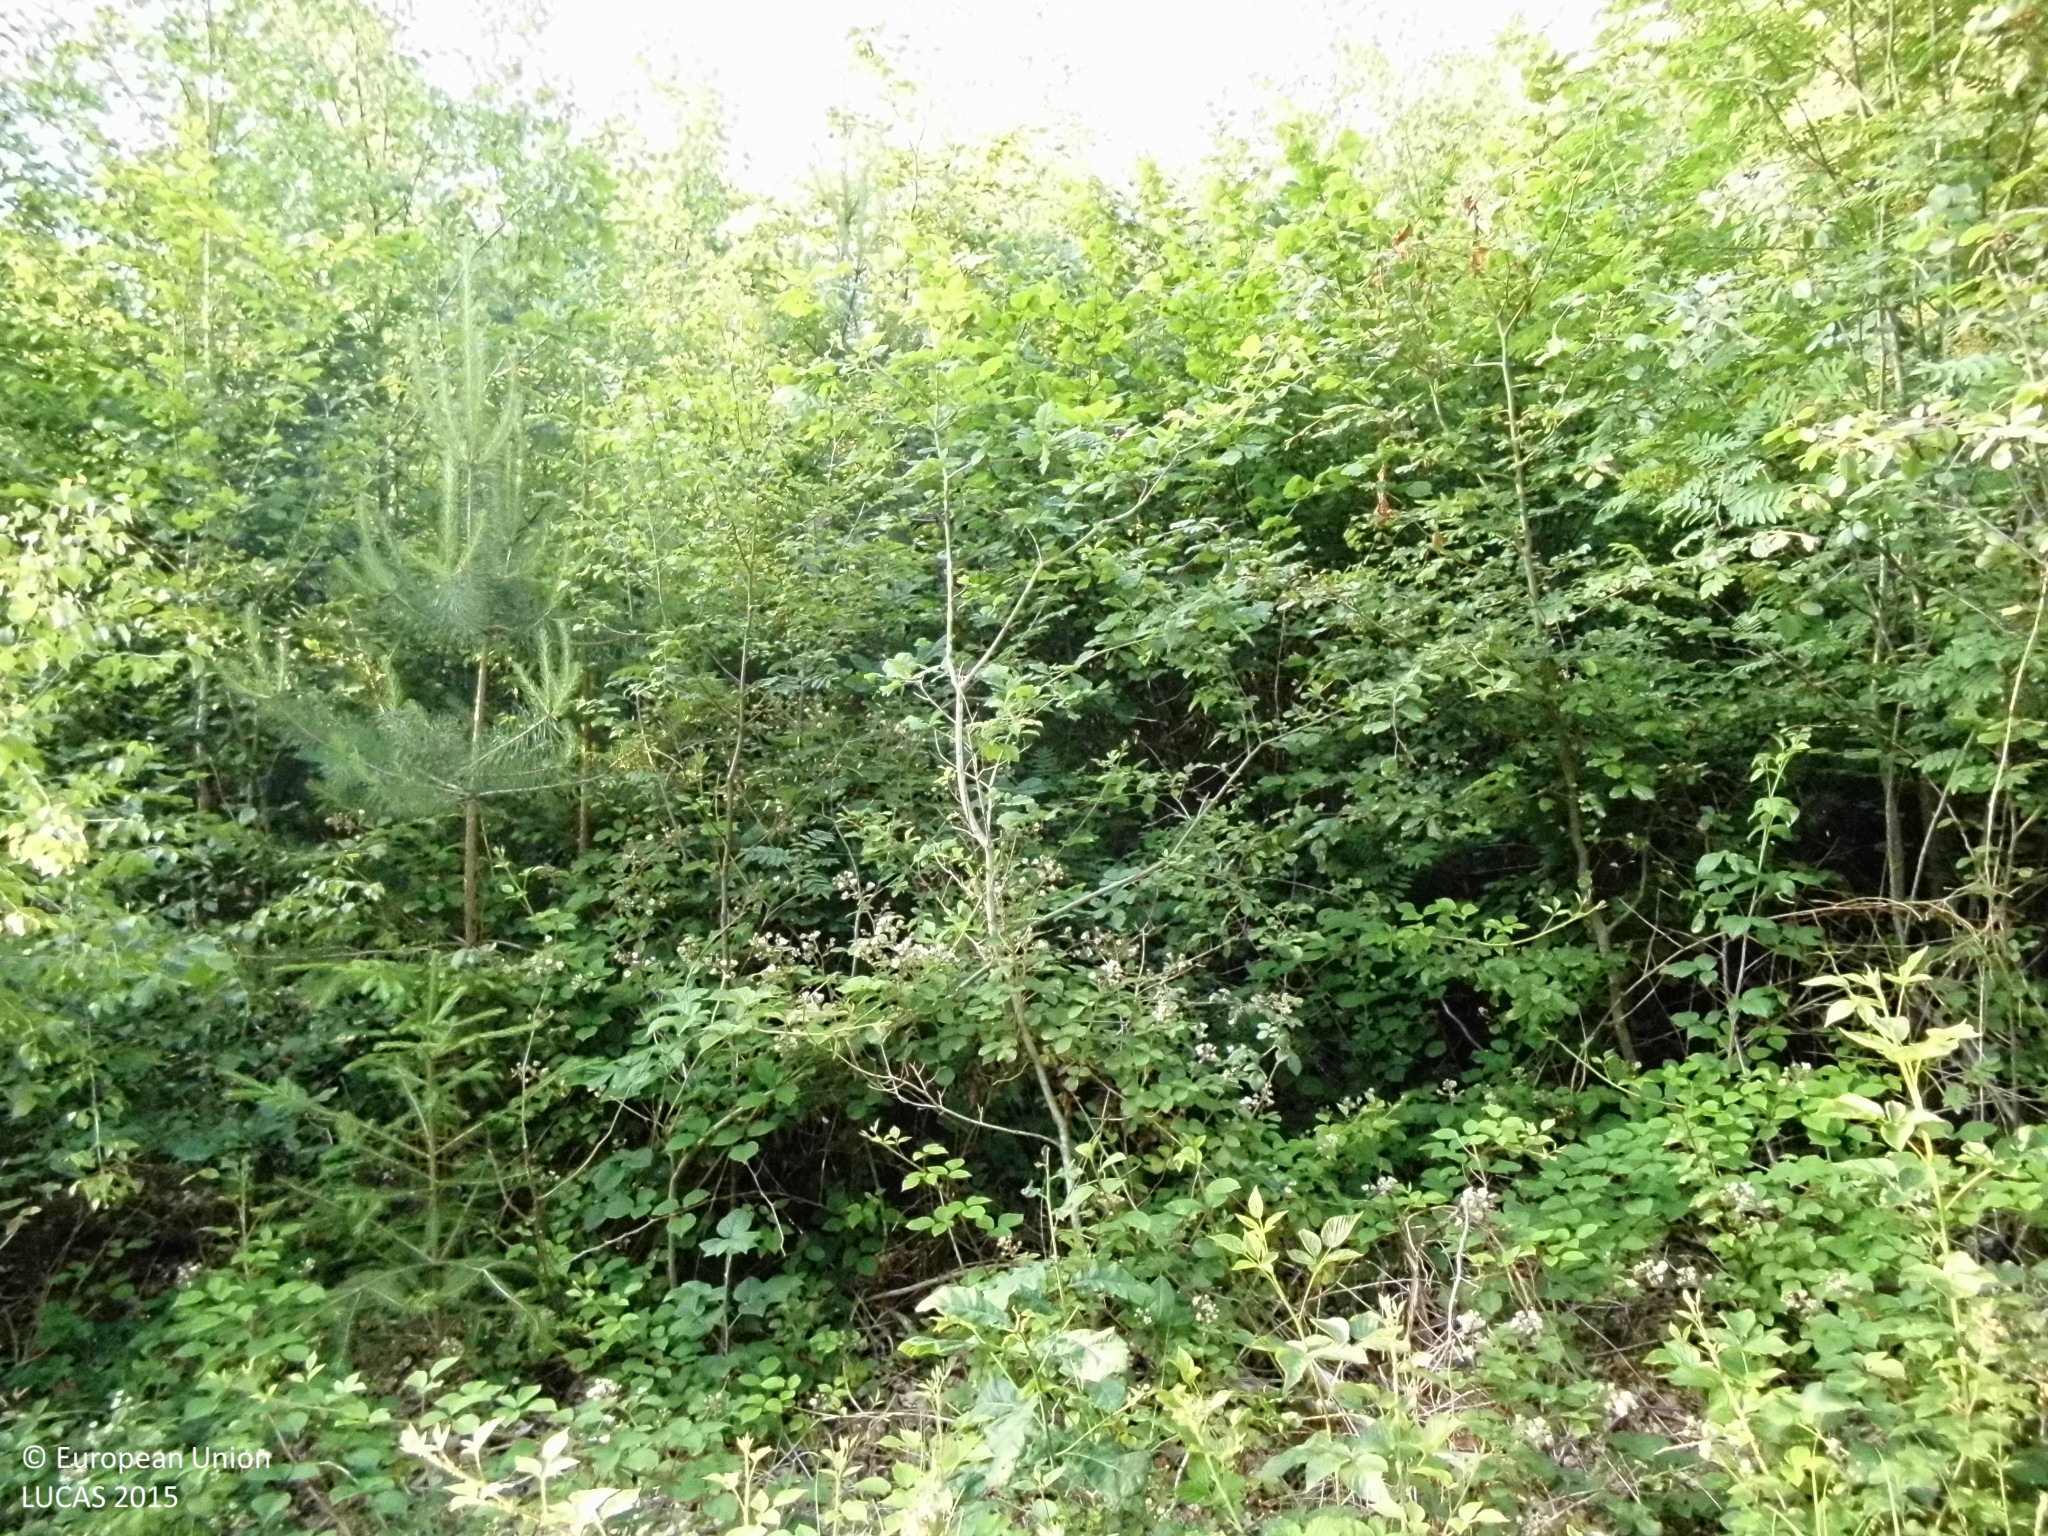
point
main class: Woodland
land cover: Broadleaved woodland
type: mesophytic deciduous forest
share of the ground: > 75 %
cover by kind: broadleaved forest trees 100 %
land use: Forestry
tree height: > 5 m
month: June
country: DE
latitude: 50.8222
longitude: 7.4876
